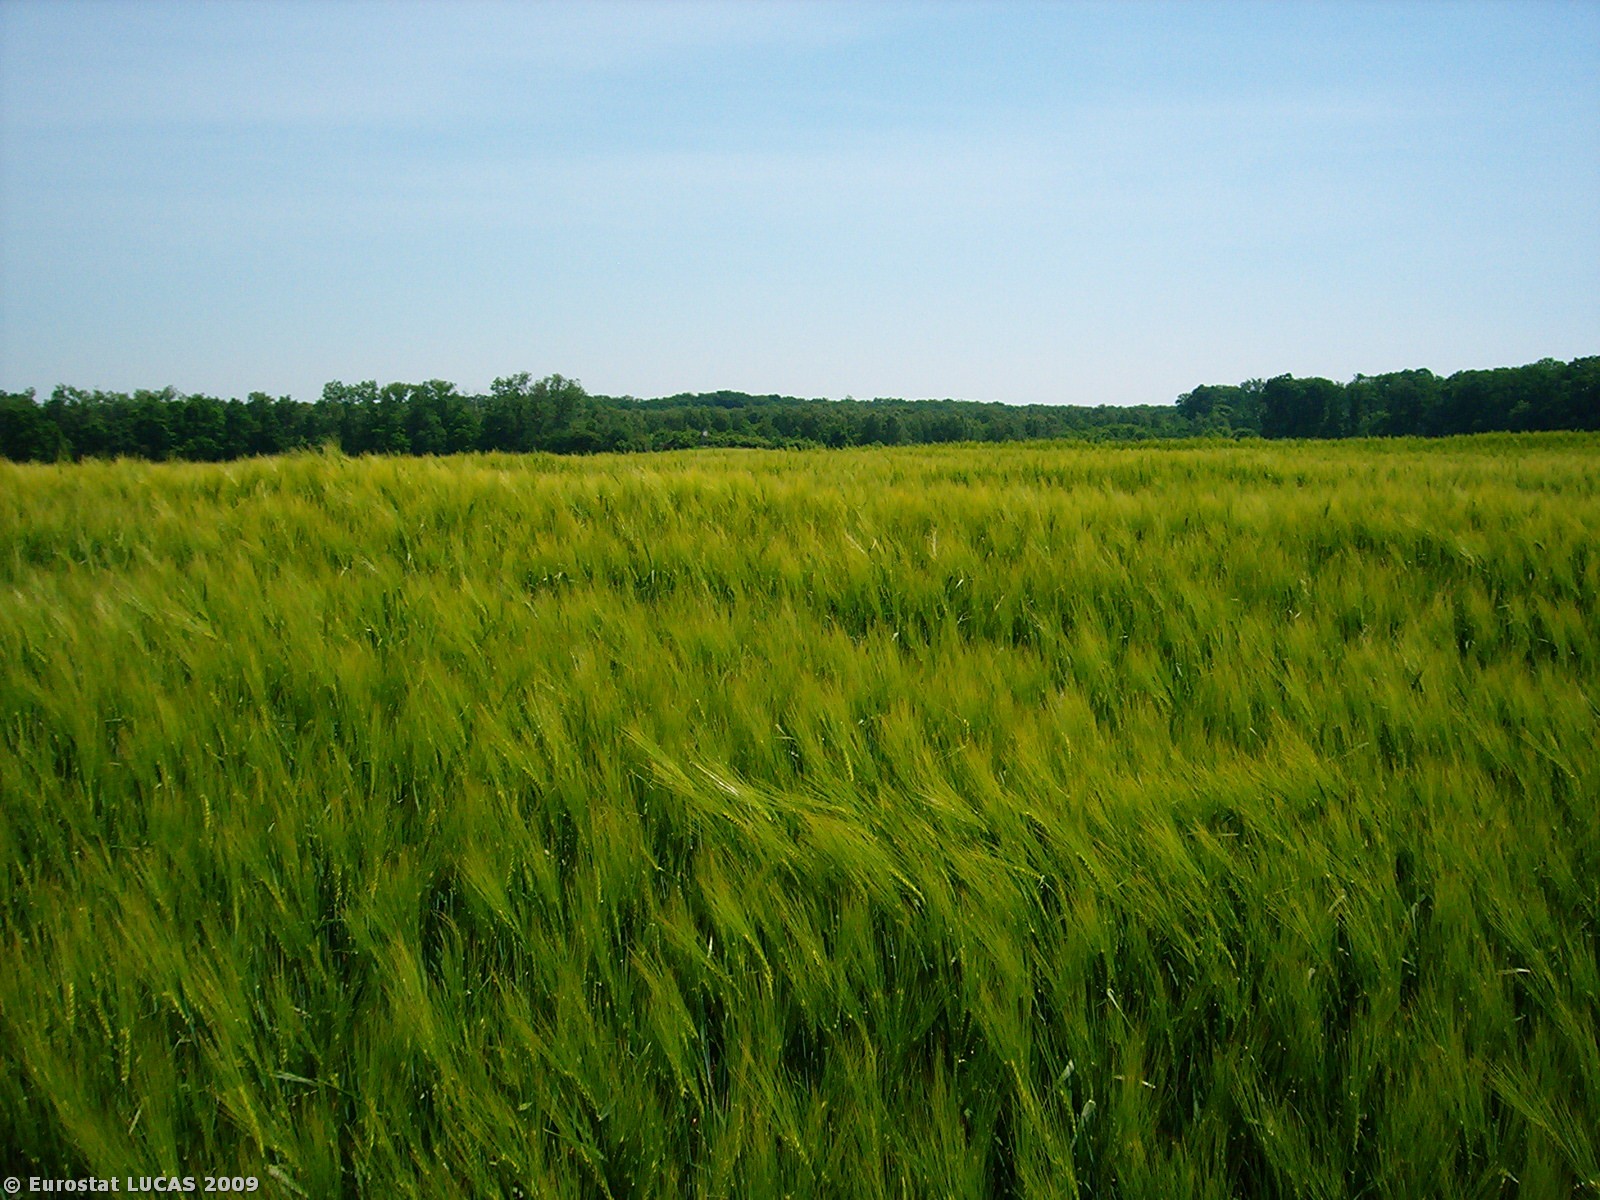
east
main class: Cropland
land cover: Barley
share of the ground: > 75 %
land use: Agriculture (excluding fallow land and kitchen gardens)
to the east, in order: Barley; Paved roads, cycling and walking lanes; Barley
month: May
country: PL
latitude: 52.5331
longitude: 16.3310
